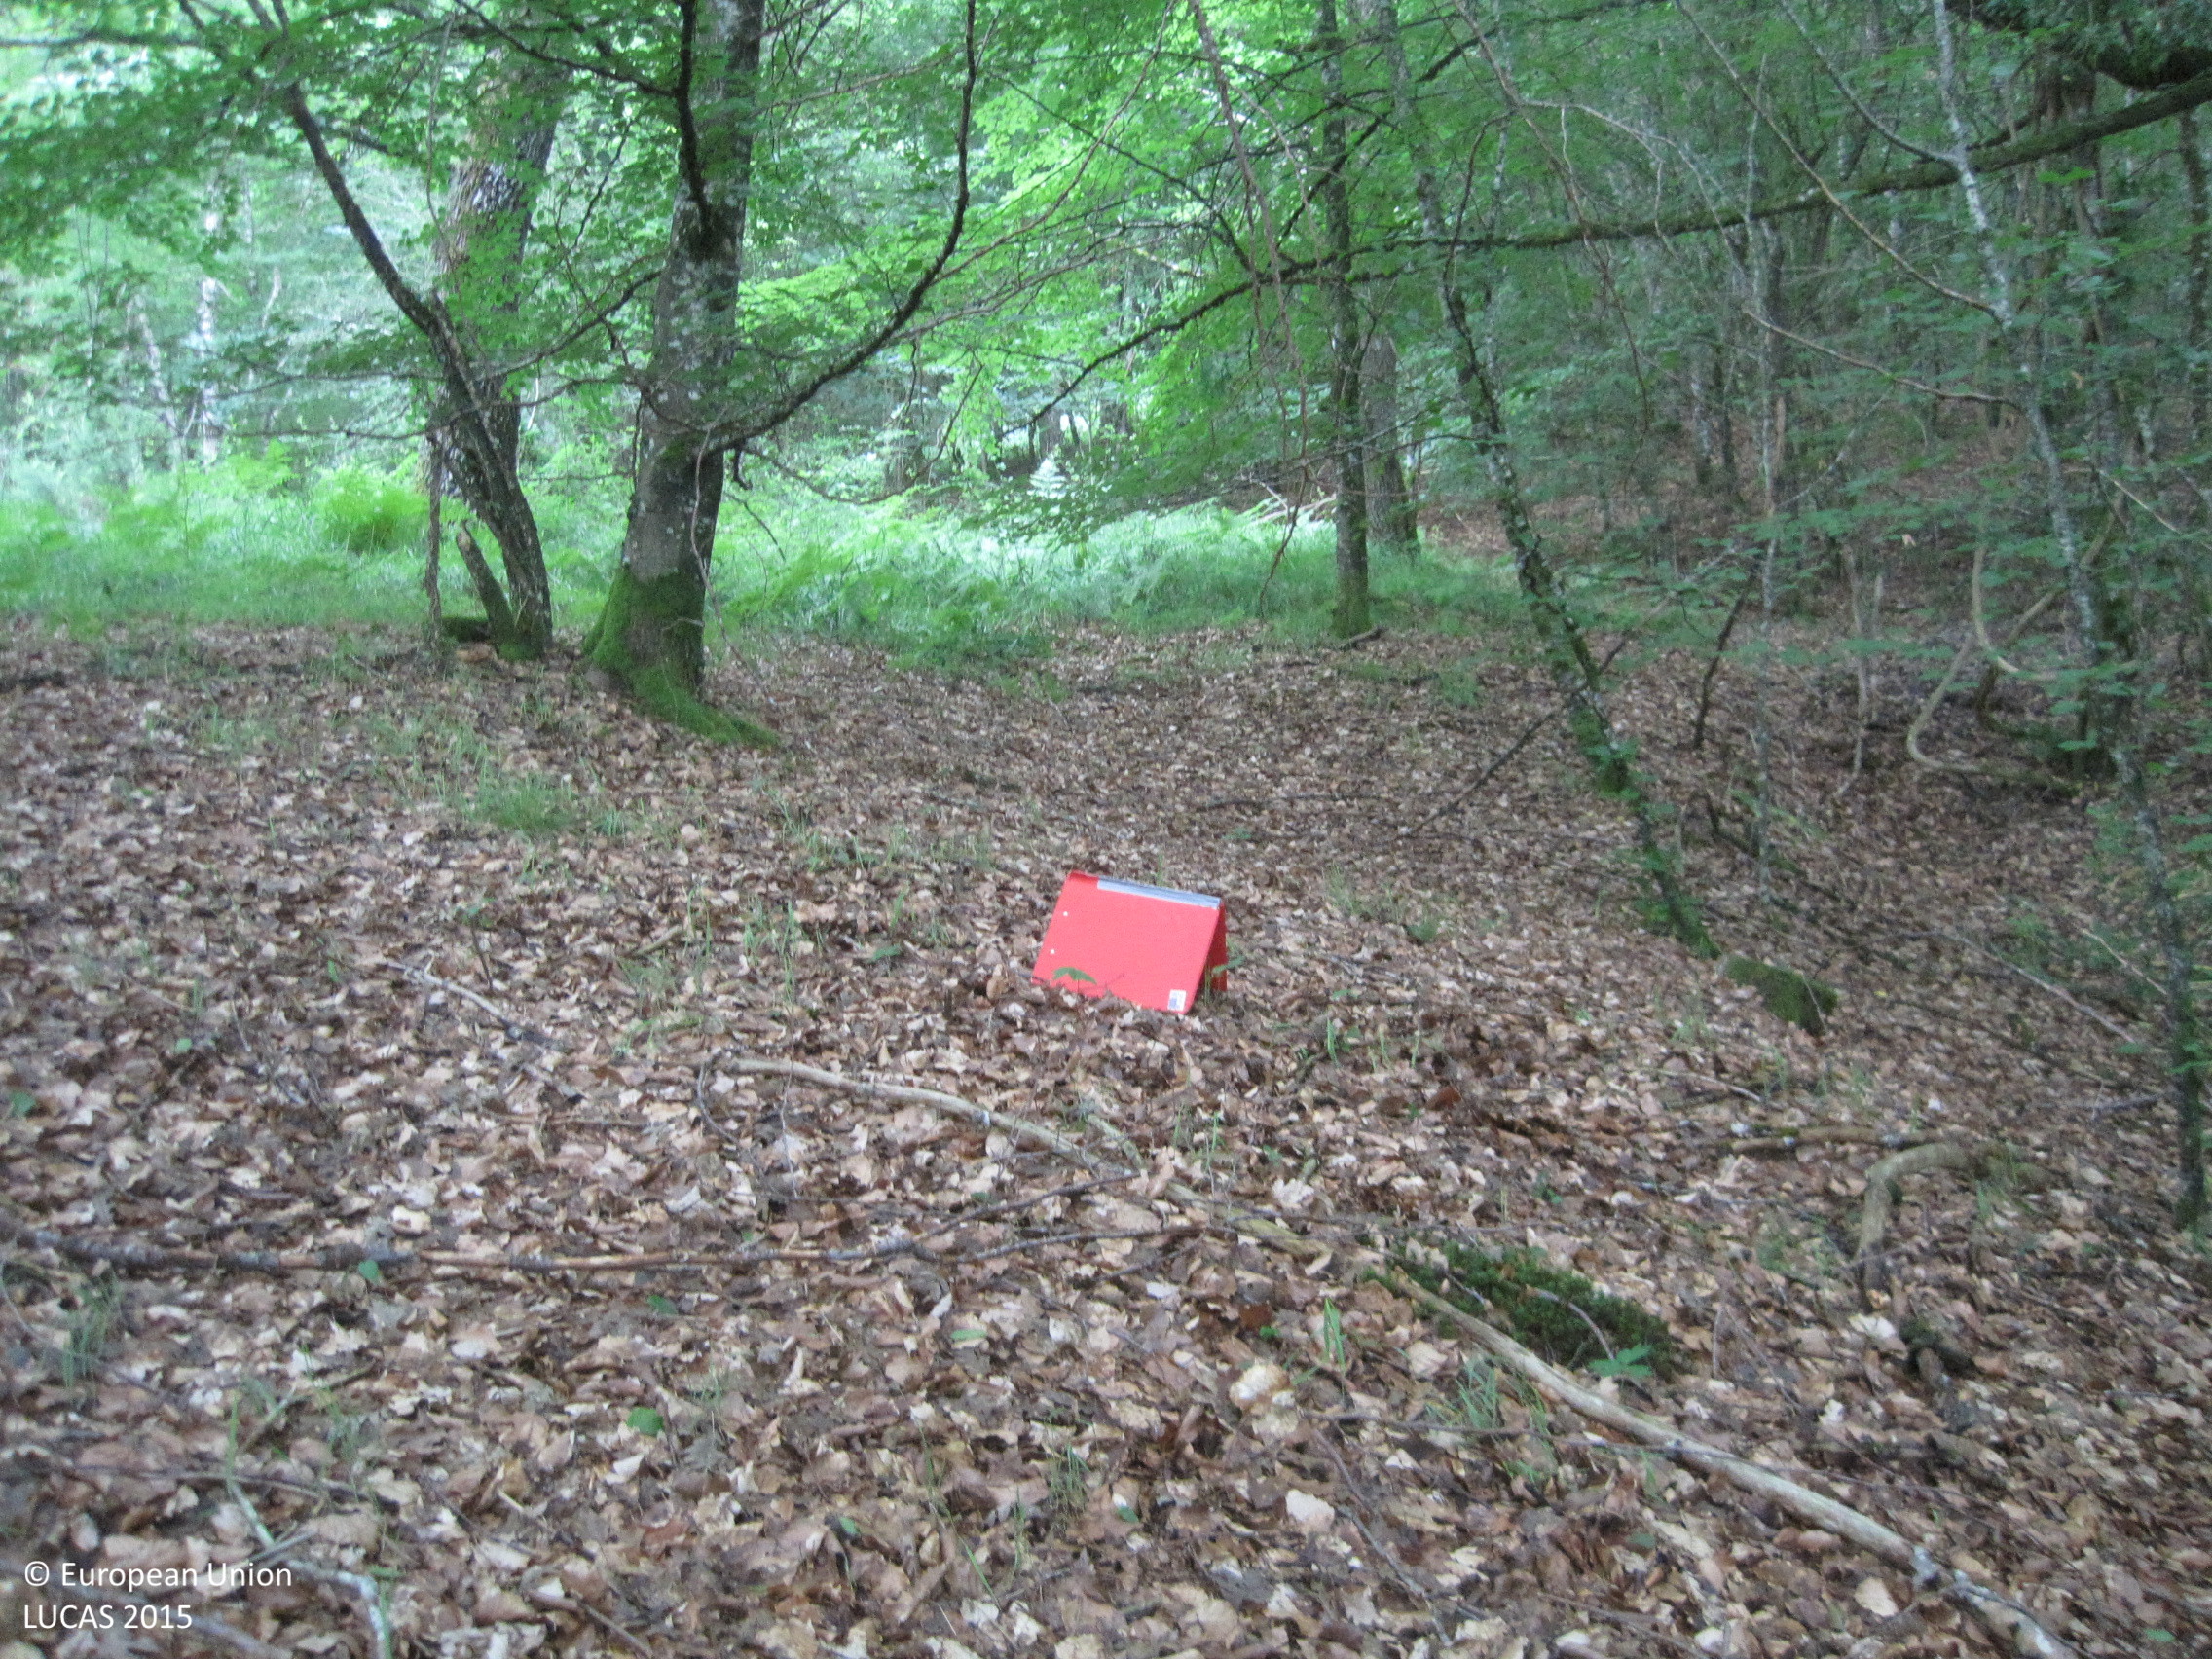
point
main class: Woodland
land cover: Broadleaved woodland
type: beech forest
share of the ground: > 75 %
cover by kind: broadleaved forest trees 100 %
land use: Forestry
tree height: > 5 m
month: June
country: ES
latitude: 43.0000
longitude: -1.8062
